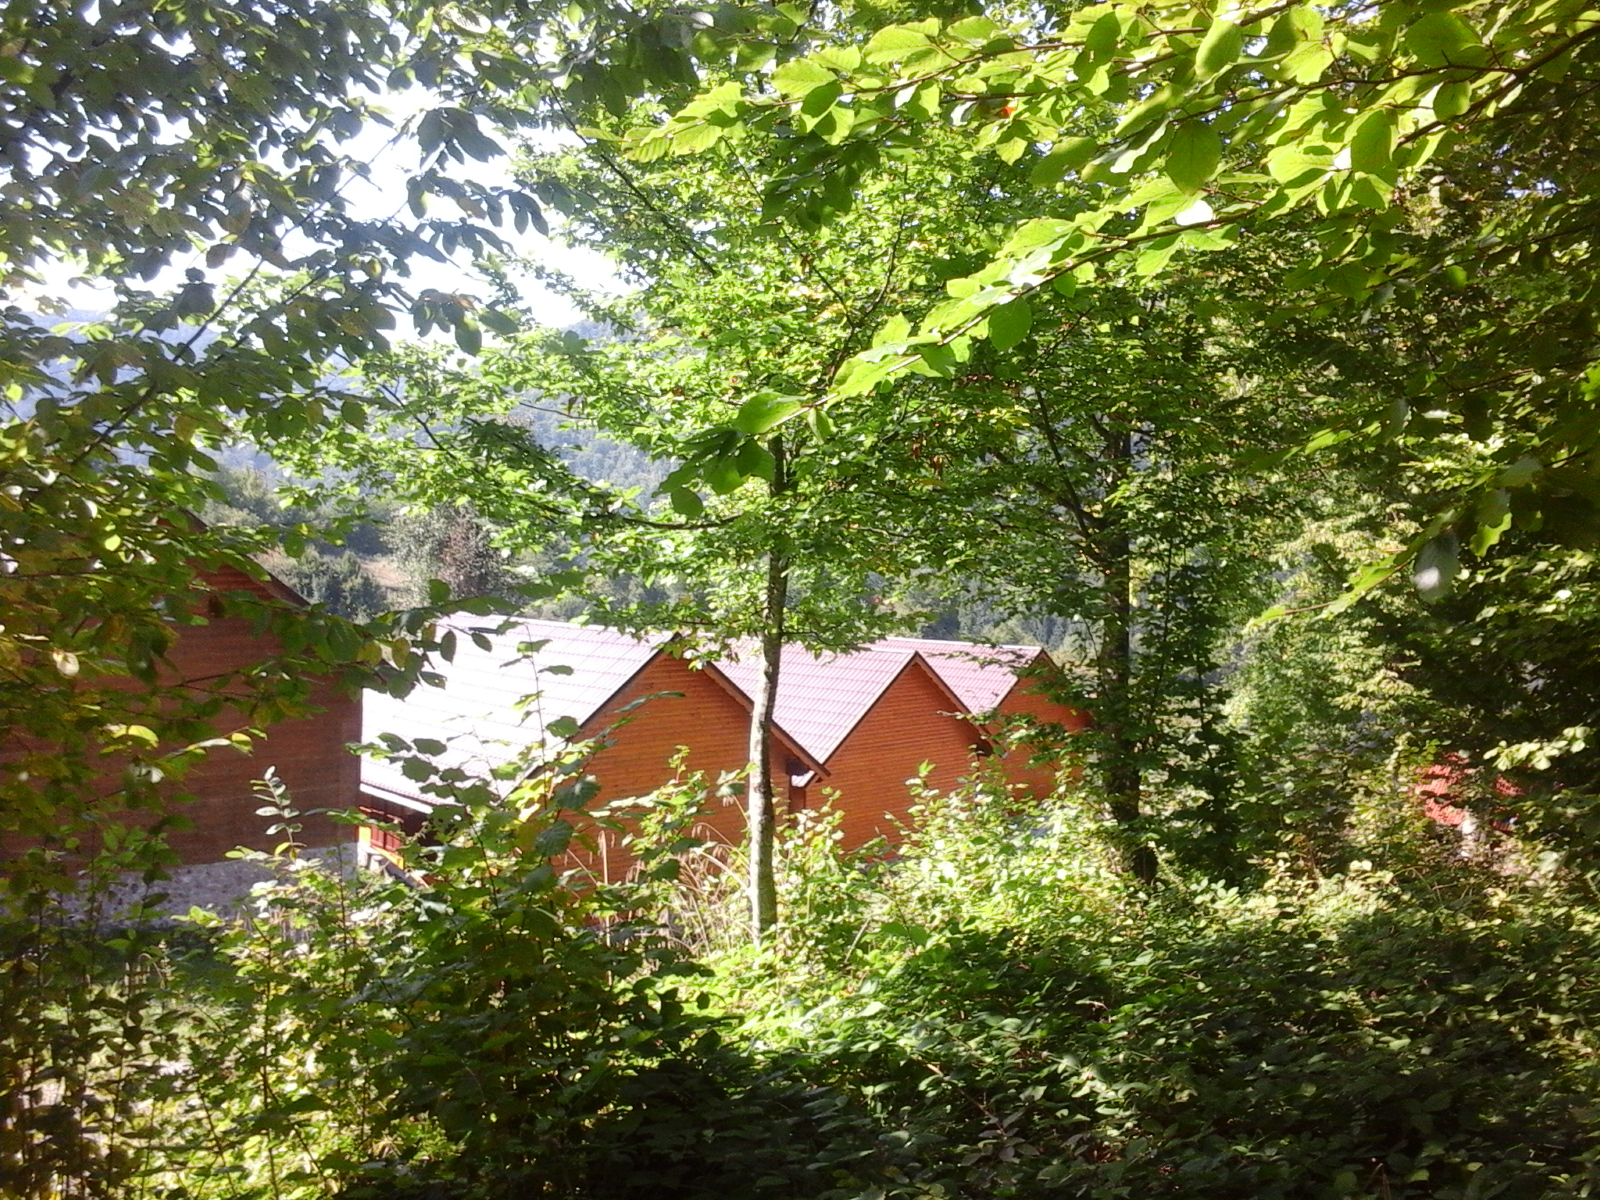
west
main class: Woodland
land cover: Broadleaved woodland
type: beech forest
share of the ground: > 75 %
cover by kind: broadleaved forest trees 100 %
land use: Forestry
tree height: > 5 m
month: September
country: RO
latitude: 46.5986
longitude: 22.6513
